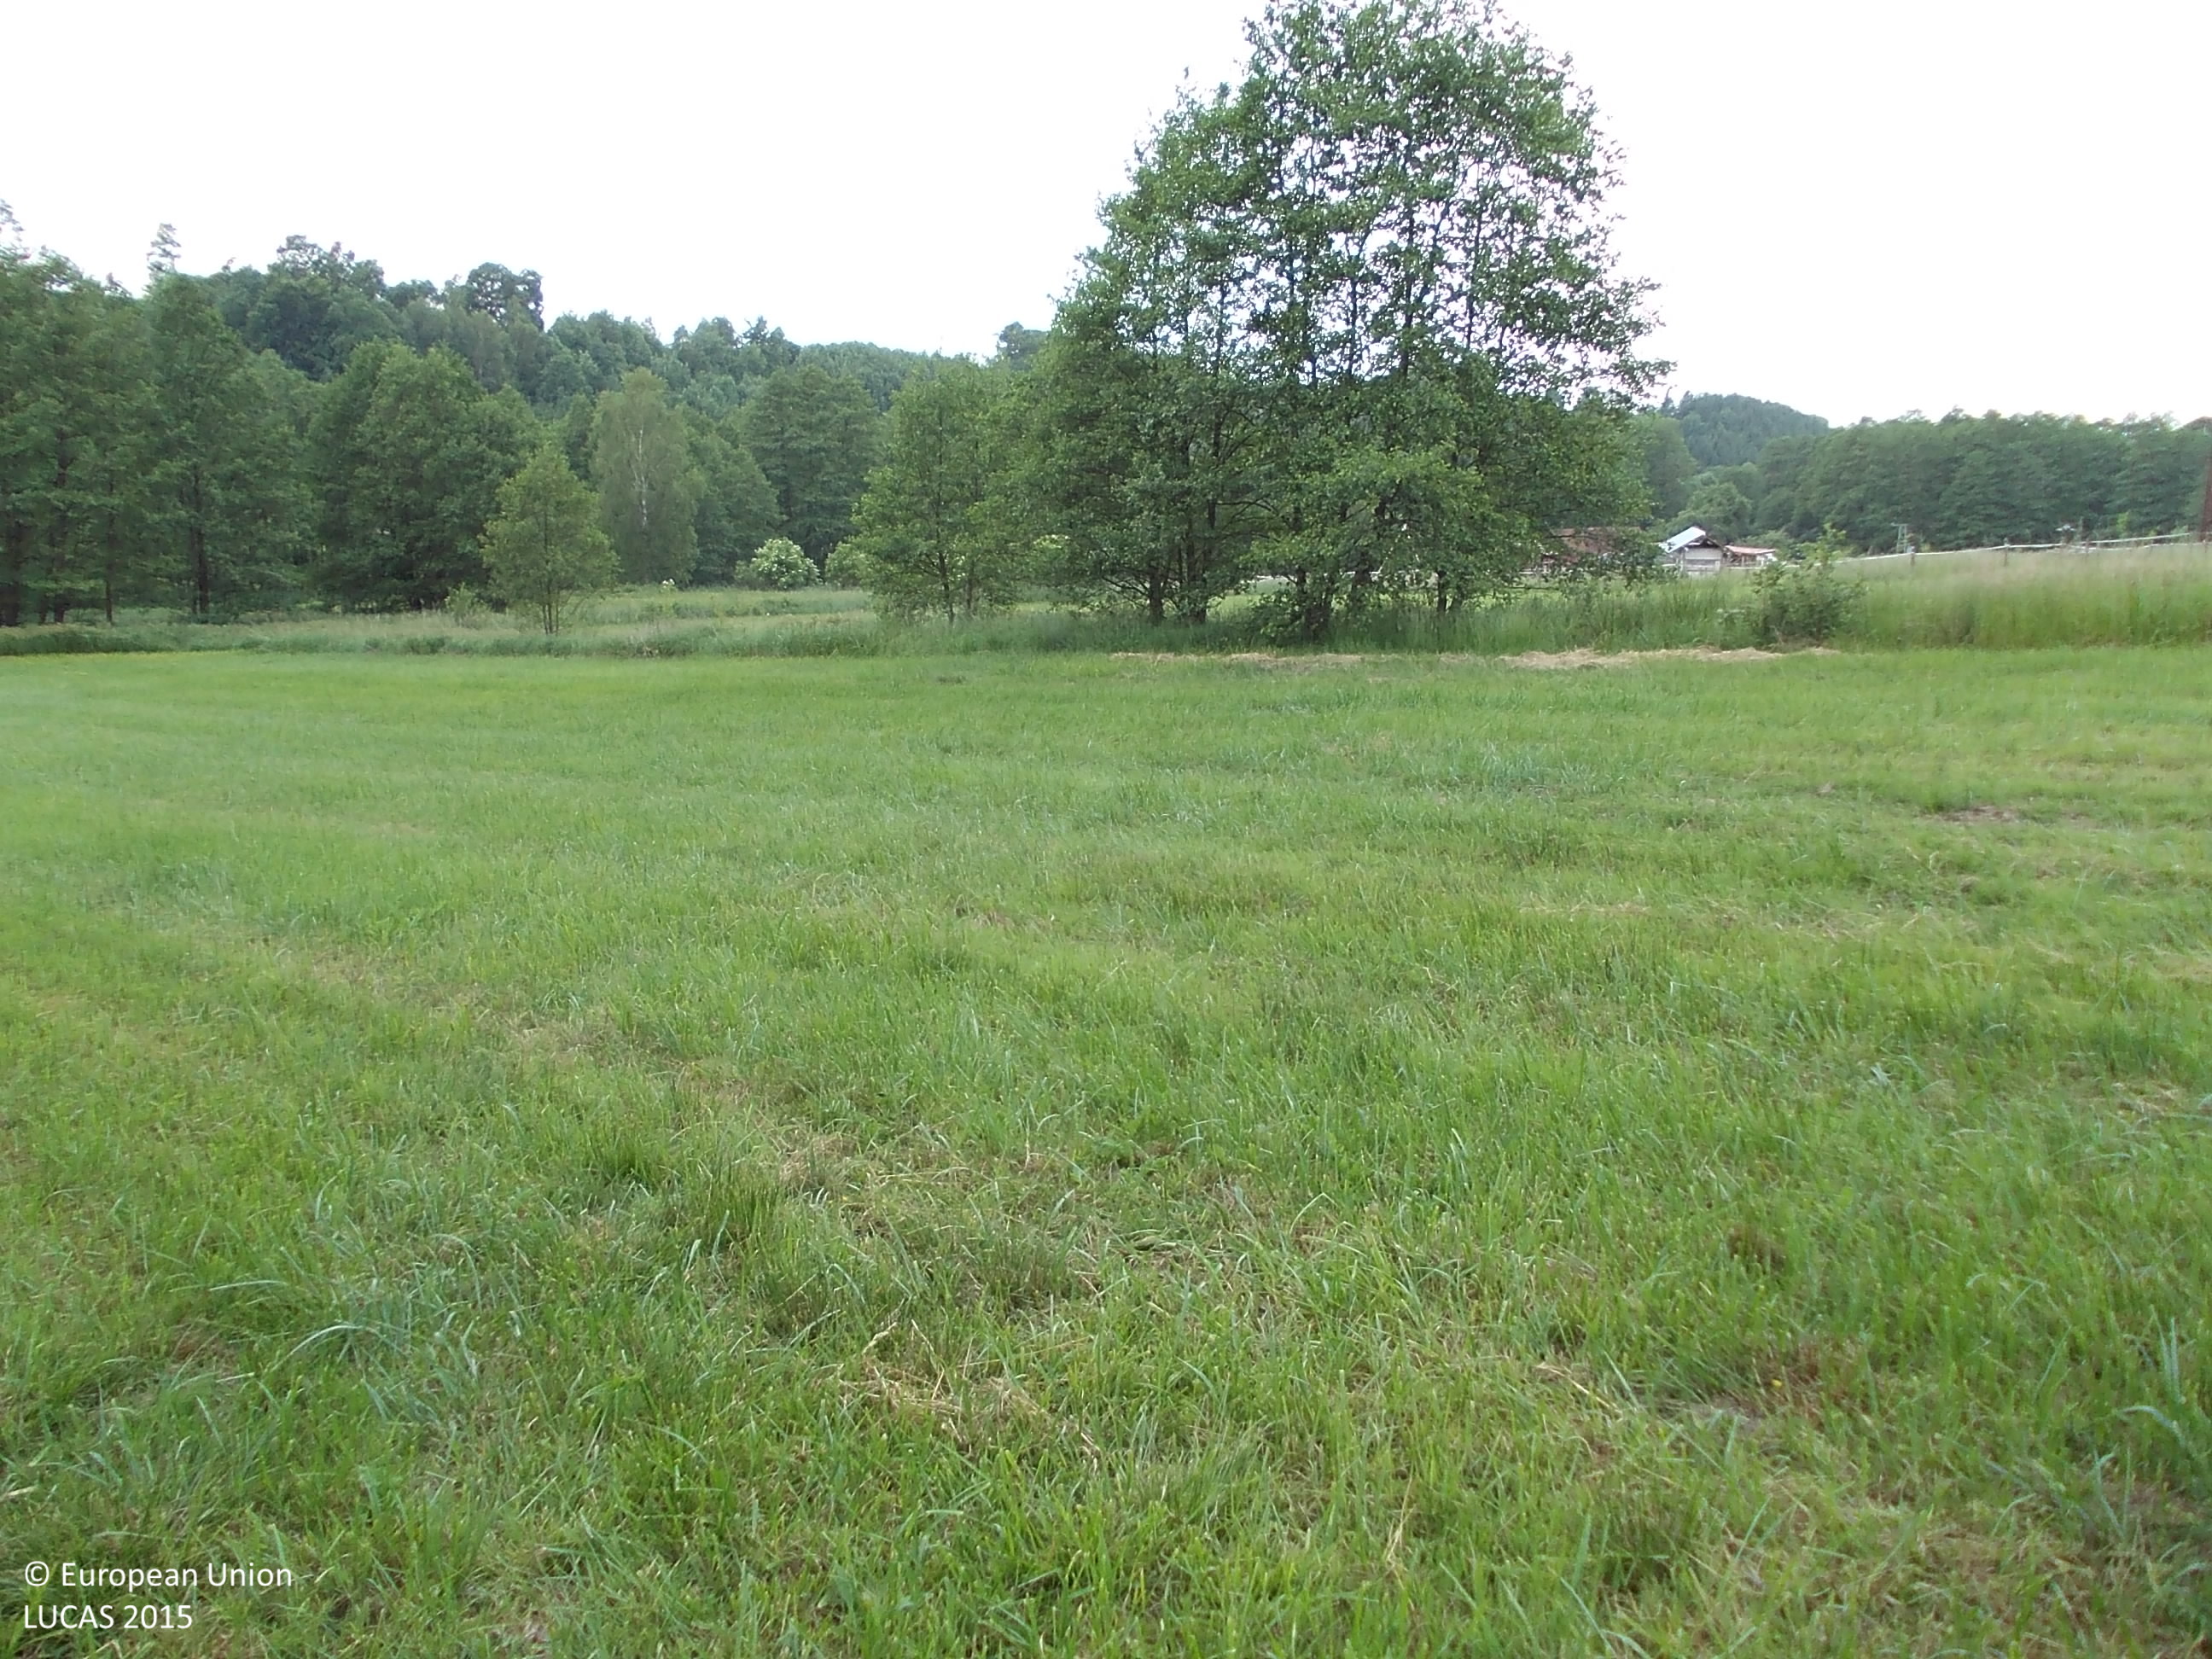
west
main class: Grassland
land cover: Grassland without tree/shrub cover
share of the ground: > 75 %
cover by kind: herbaceous plants 100 %
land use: Agriculture (excluding fallow land and kitchen gardens)
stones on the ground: > 50 %
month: June
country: CZ
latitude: 50.0606
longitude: 16.3628
